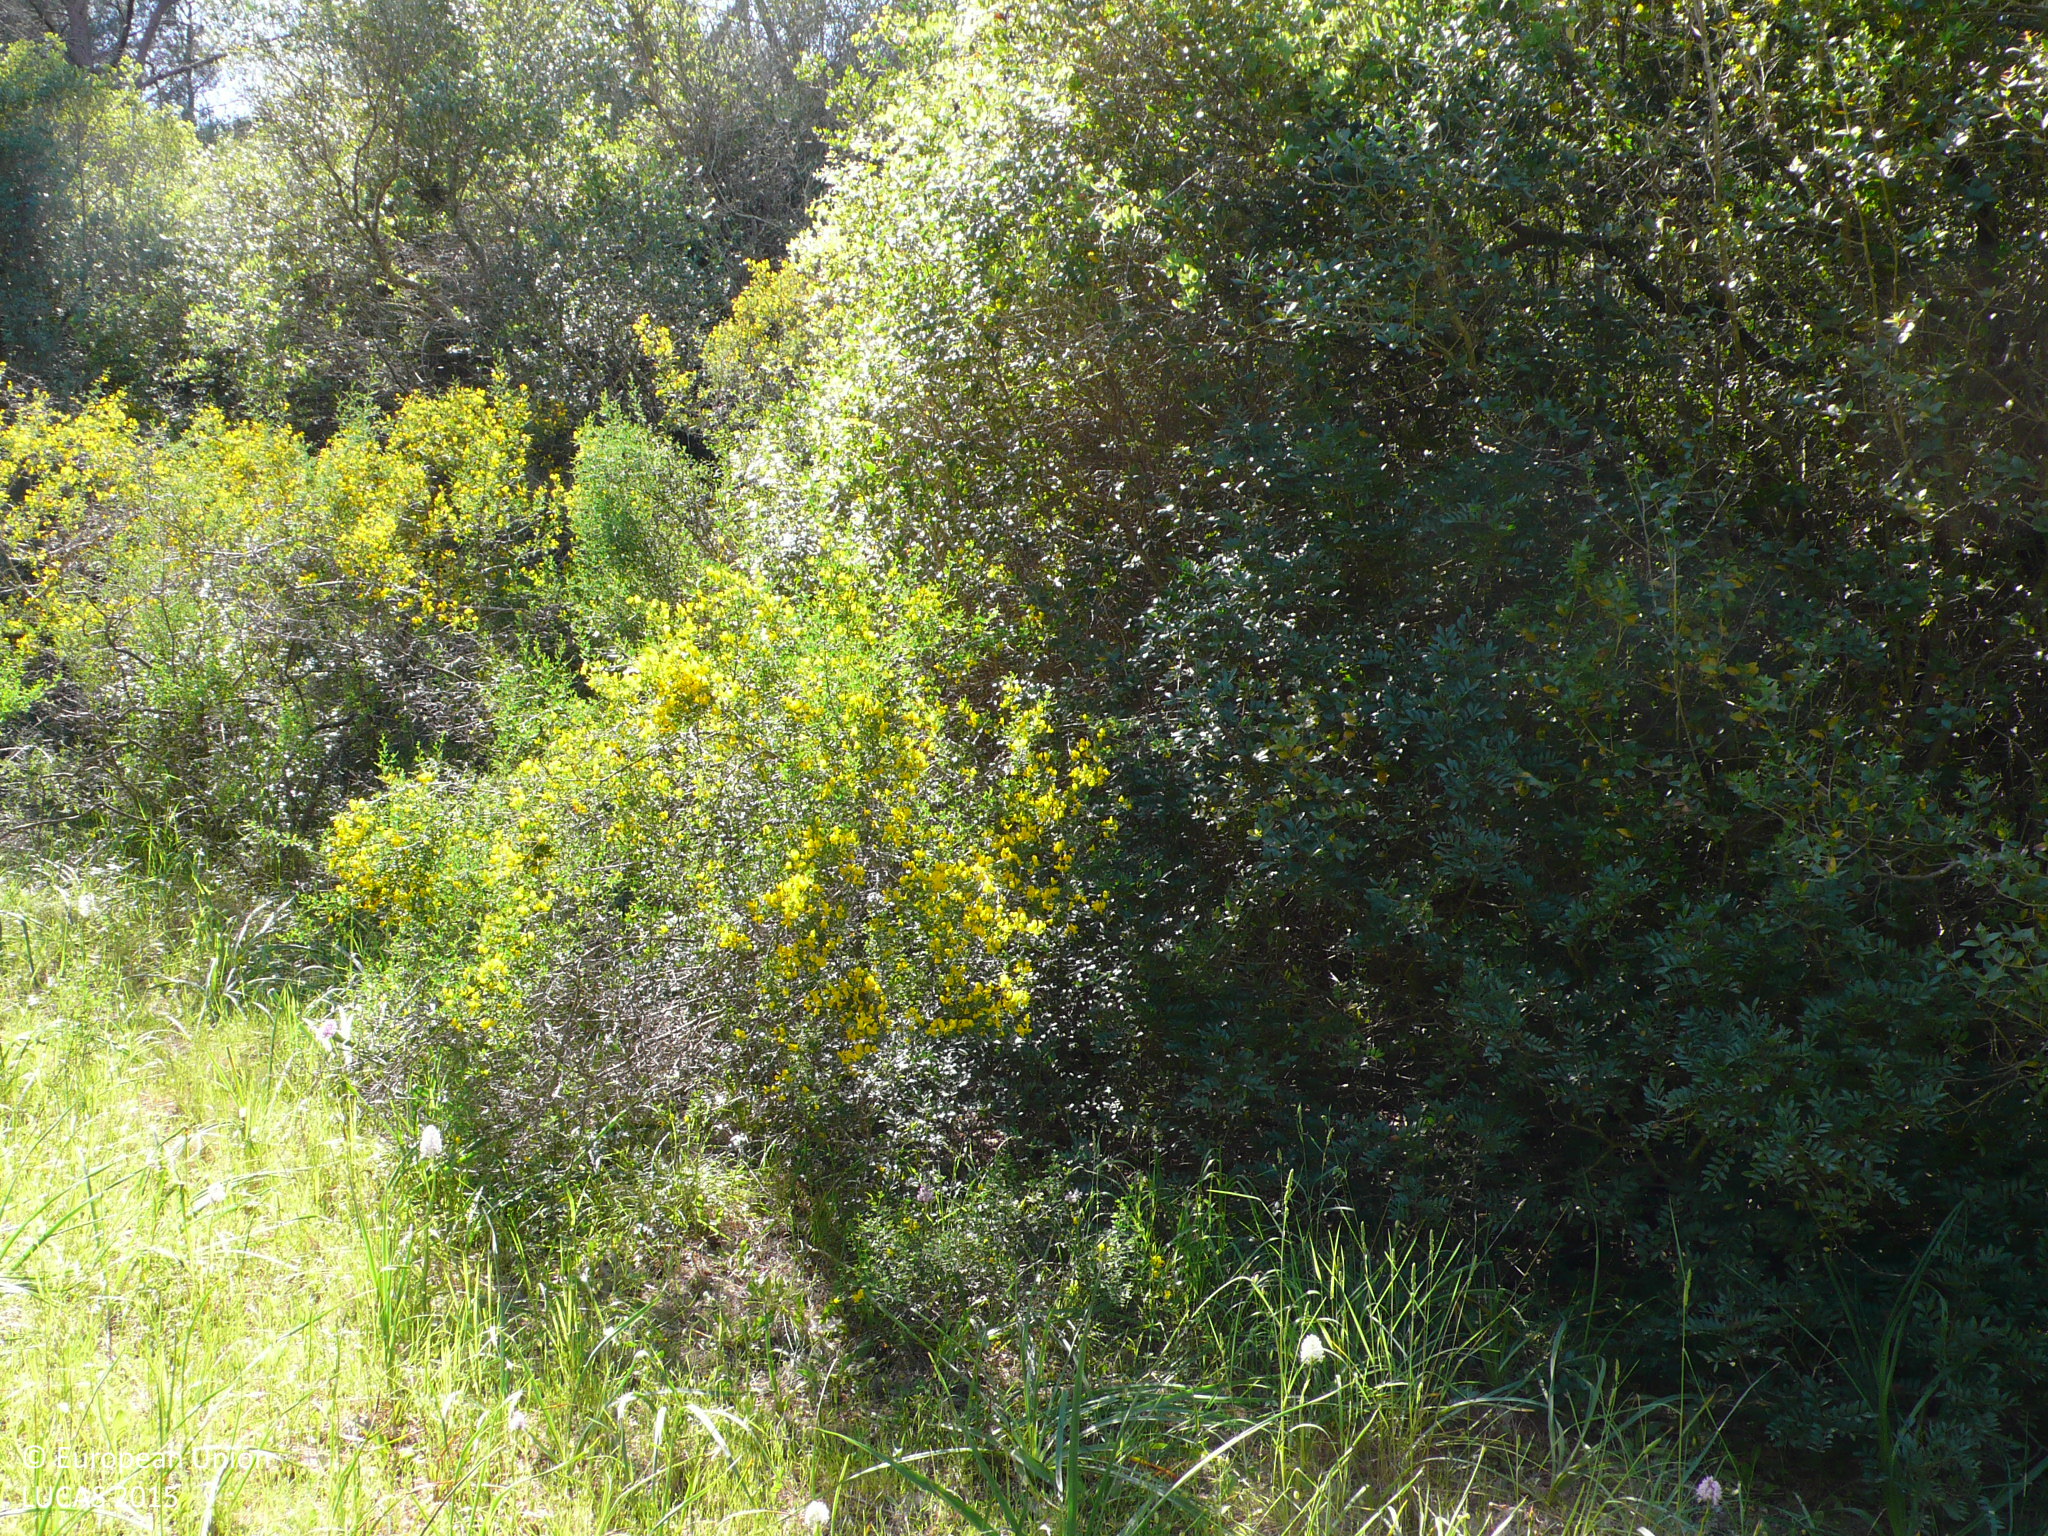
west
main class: Woodland
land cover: Other mixed woodland
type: coniferous forest of the mediterranean region
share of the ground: > 75 %
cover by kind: coniferous forest trees 50 %, broadleaved forest trees 45 %, shrubs 5 %
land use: Semi-natural and natural areas not in use
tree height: > 5 m
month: May
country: ES
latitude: 39.9260
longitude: 4.0940
